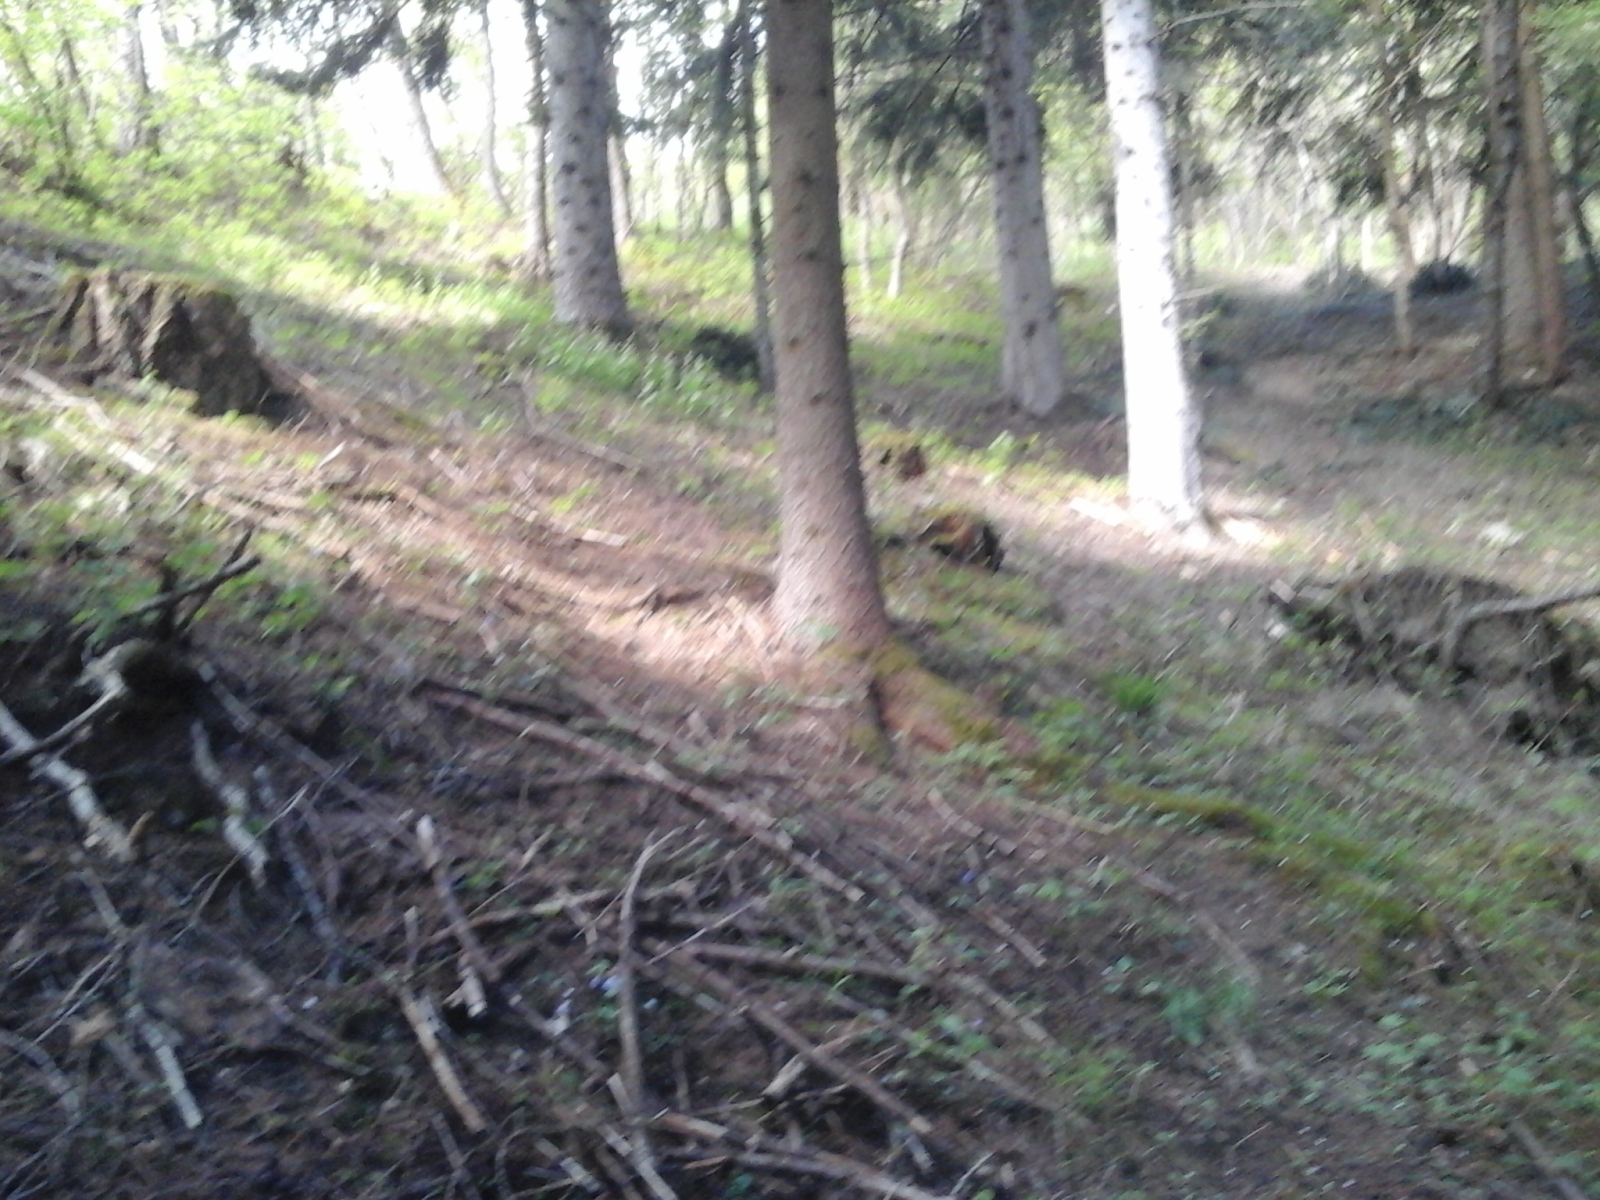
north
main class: Woodland
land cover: Spruce dominated coniferous woodland
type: alpine coniferous forest
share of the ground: > 75 %
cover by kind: coniferous forest trees 85 %, broadleaved forest trees 5 %, shrubs 5 %, herbaceous plants 5 %
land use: Forestry
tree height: > 5 m
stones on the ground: < 10 %
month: May
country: IT
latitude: 46.3475
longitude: 10.8954
